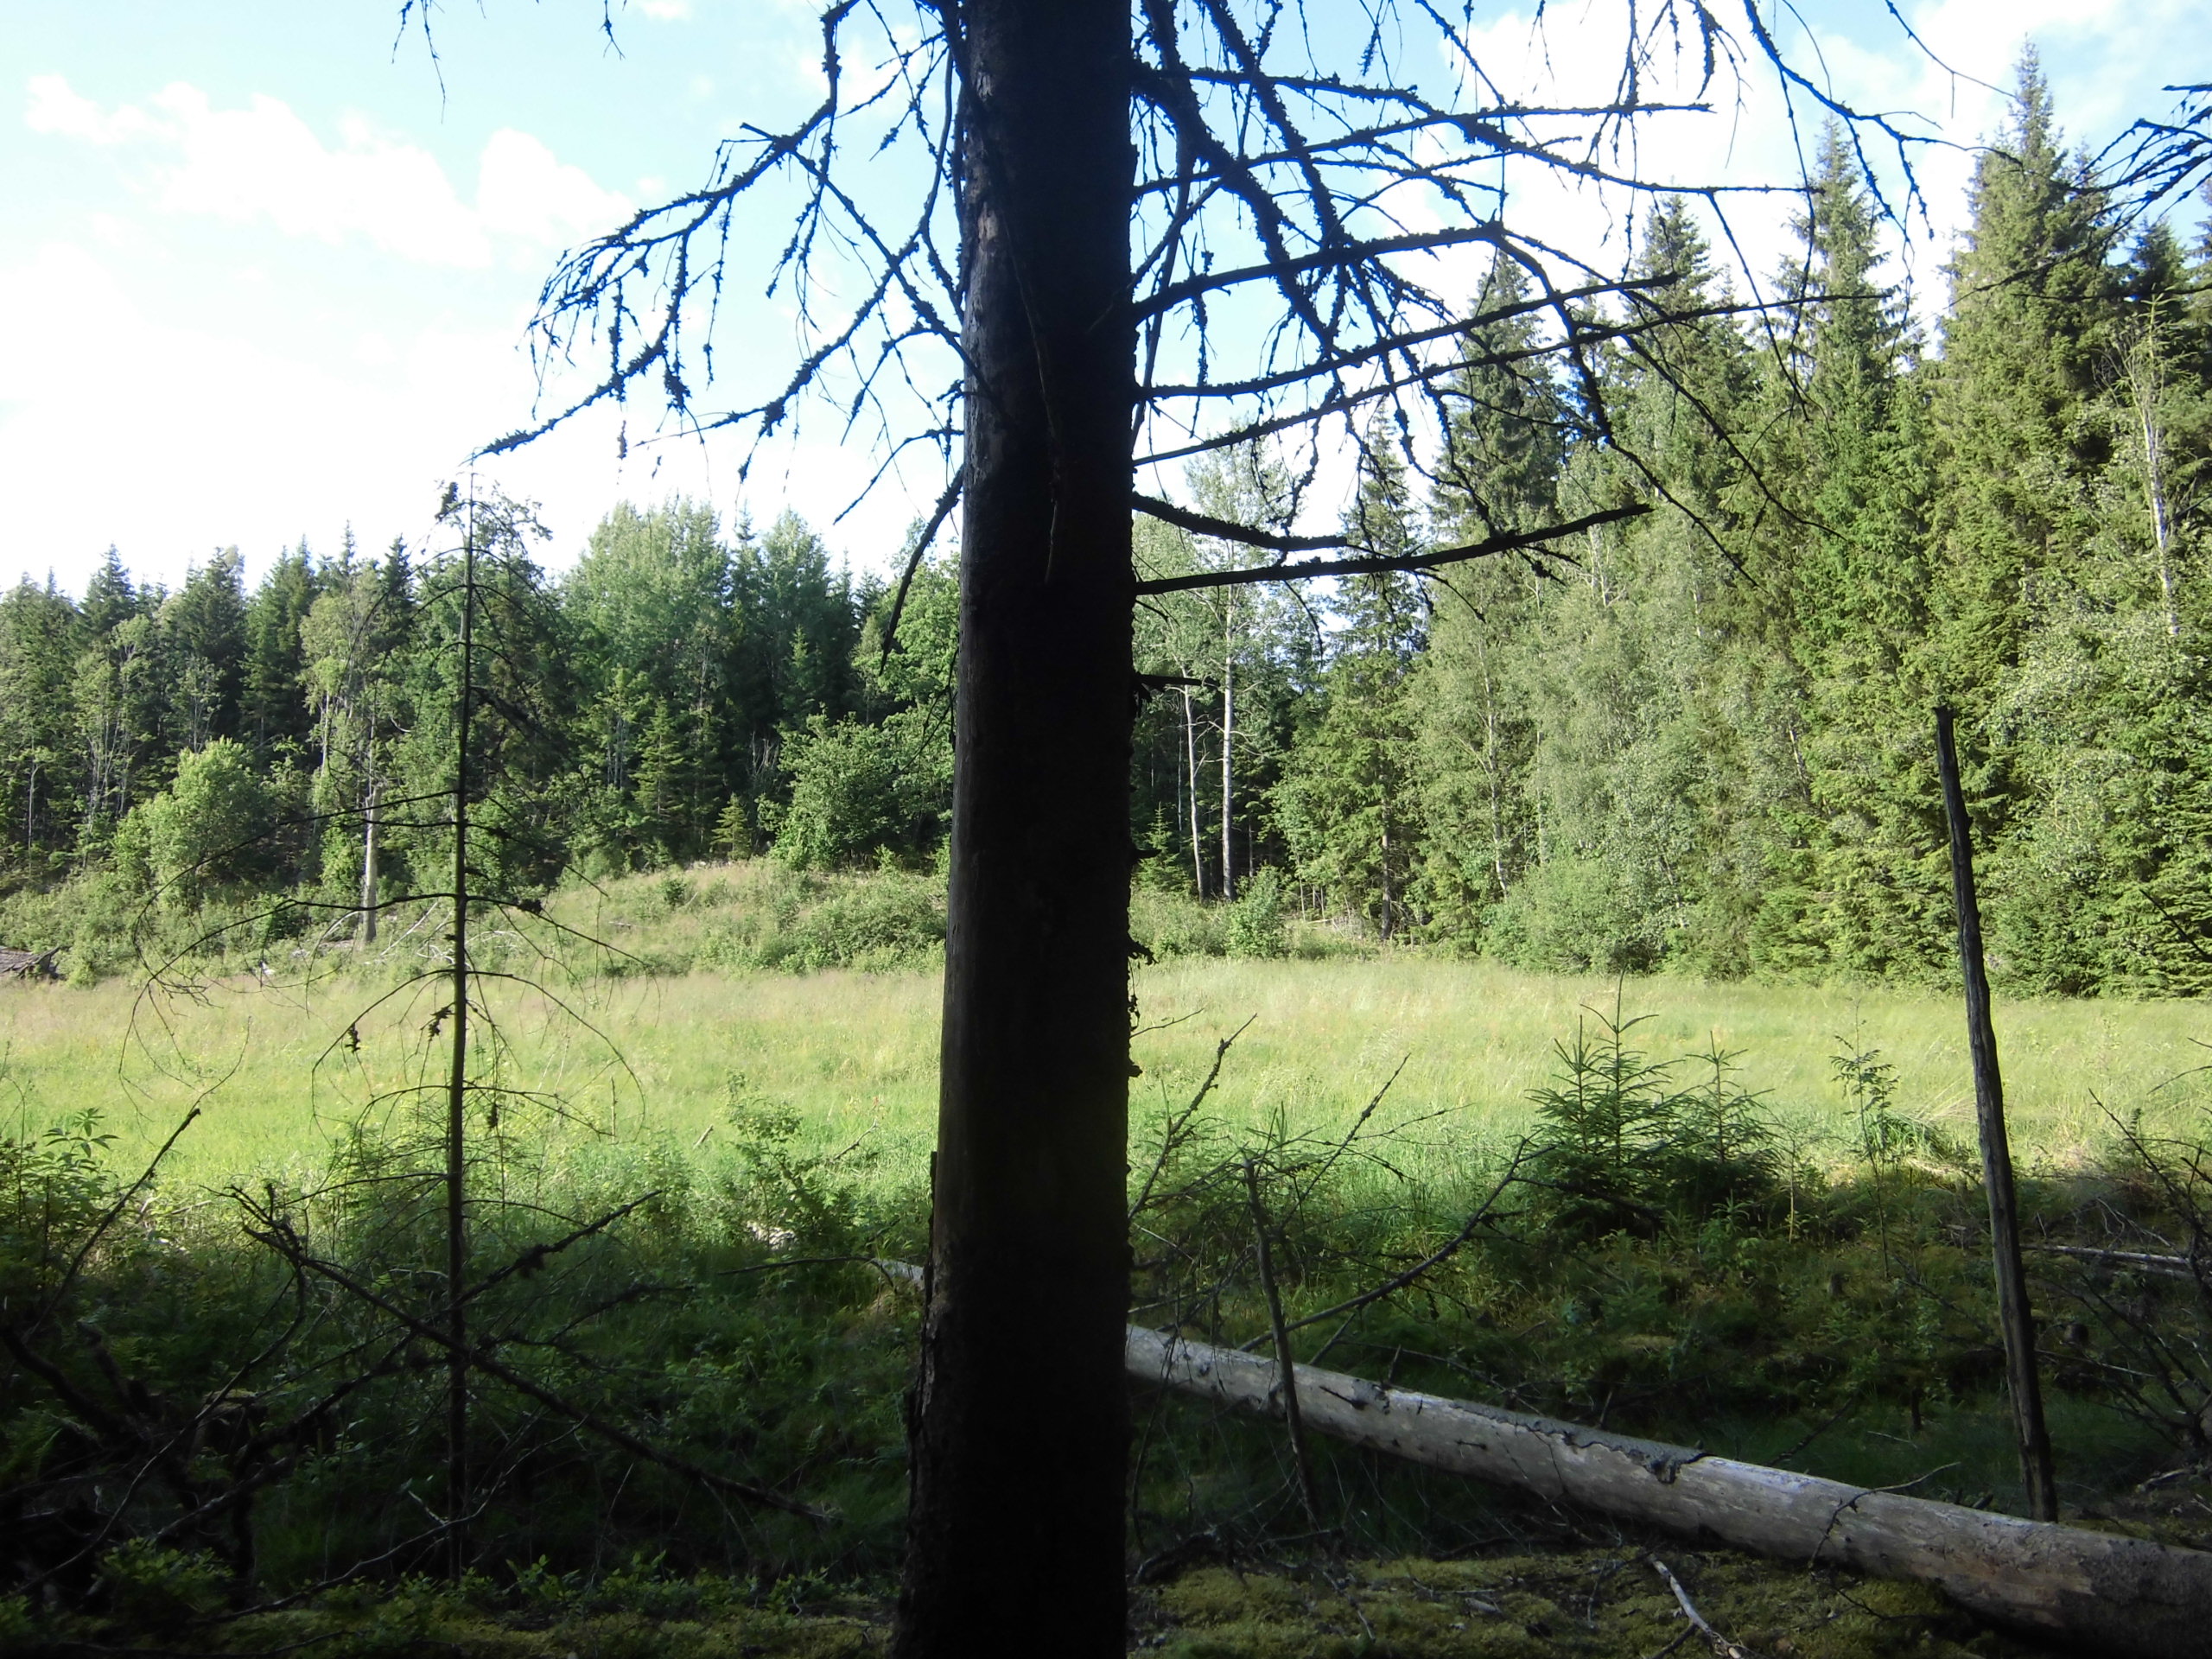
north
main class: Woodland
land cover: Spruce dominated coniferous woodland
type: boreal forest
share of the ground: 50 - 75 %
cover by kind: coniferous forest trees 60 %, shrubs 20 %, herbaceous plants 10 %, lichens and mosses 10 %
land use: Forestry
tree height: > 5 m
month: July
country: SE
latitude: 57.1774
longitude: 15.3070
